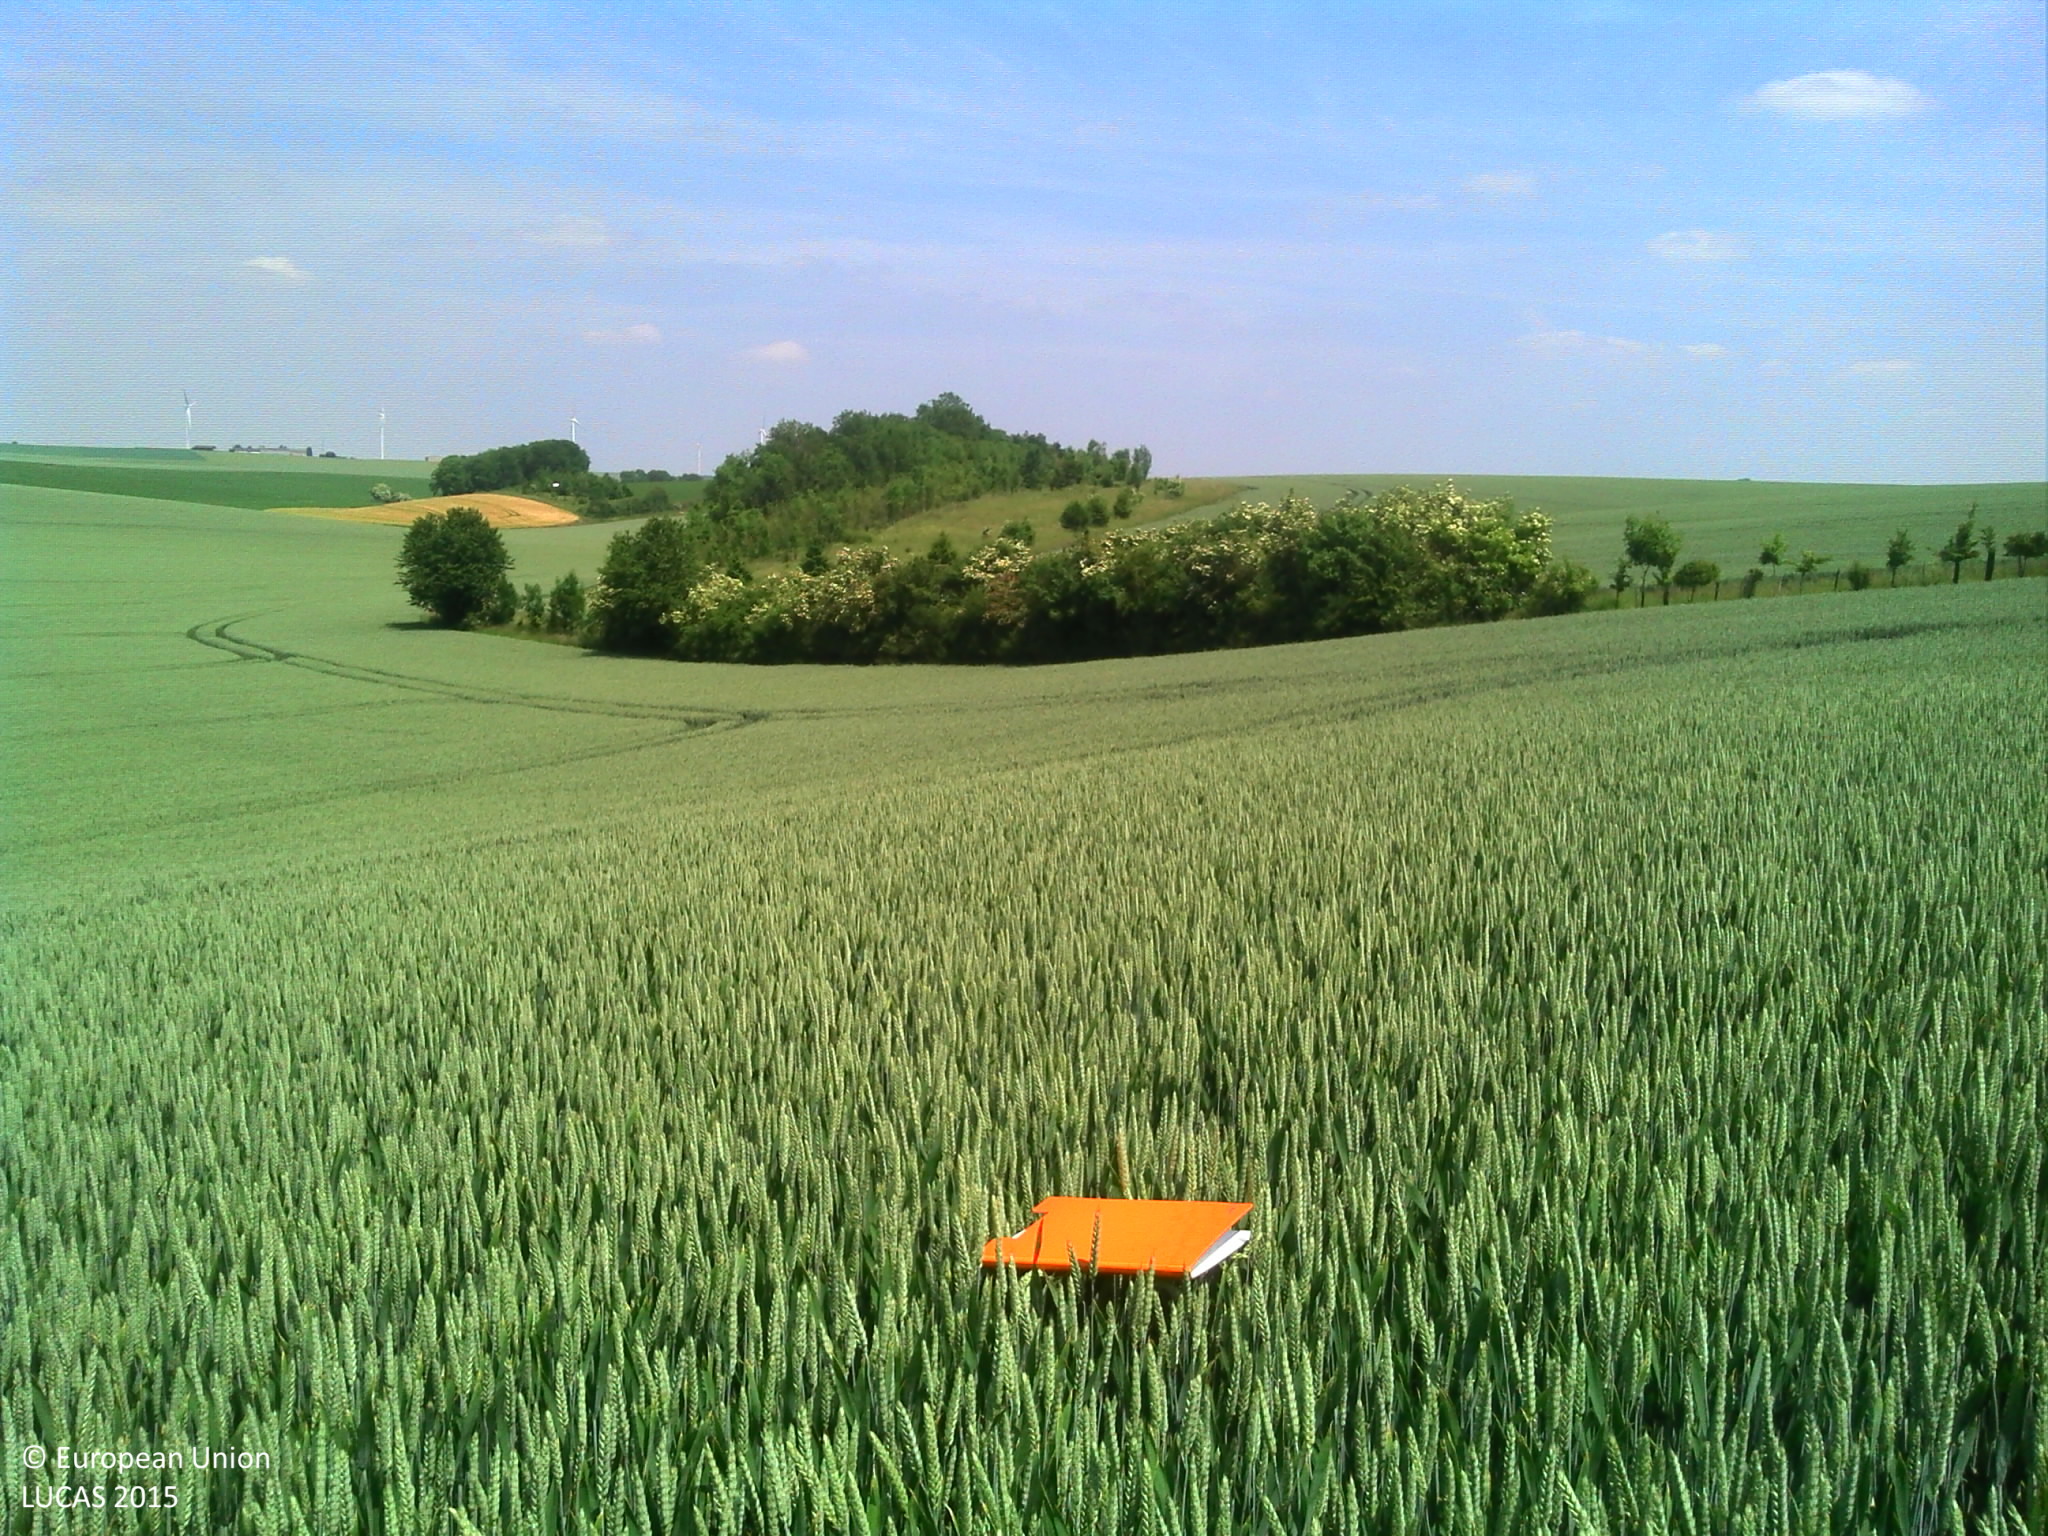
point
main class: Cropland
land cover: Common wheat
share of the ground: > 75 %
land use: Agriculture (excluding fallow land and kitchen gardens)
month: June
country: FR
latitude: 49.5951
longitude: 4.0319
